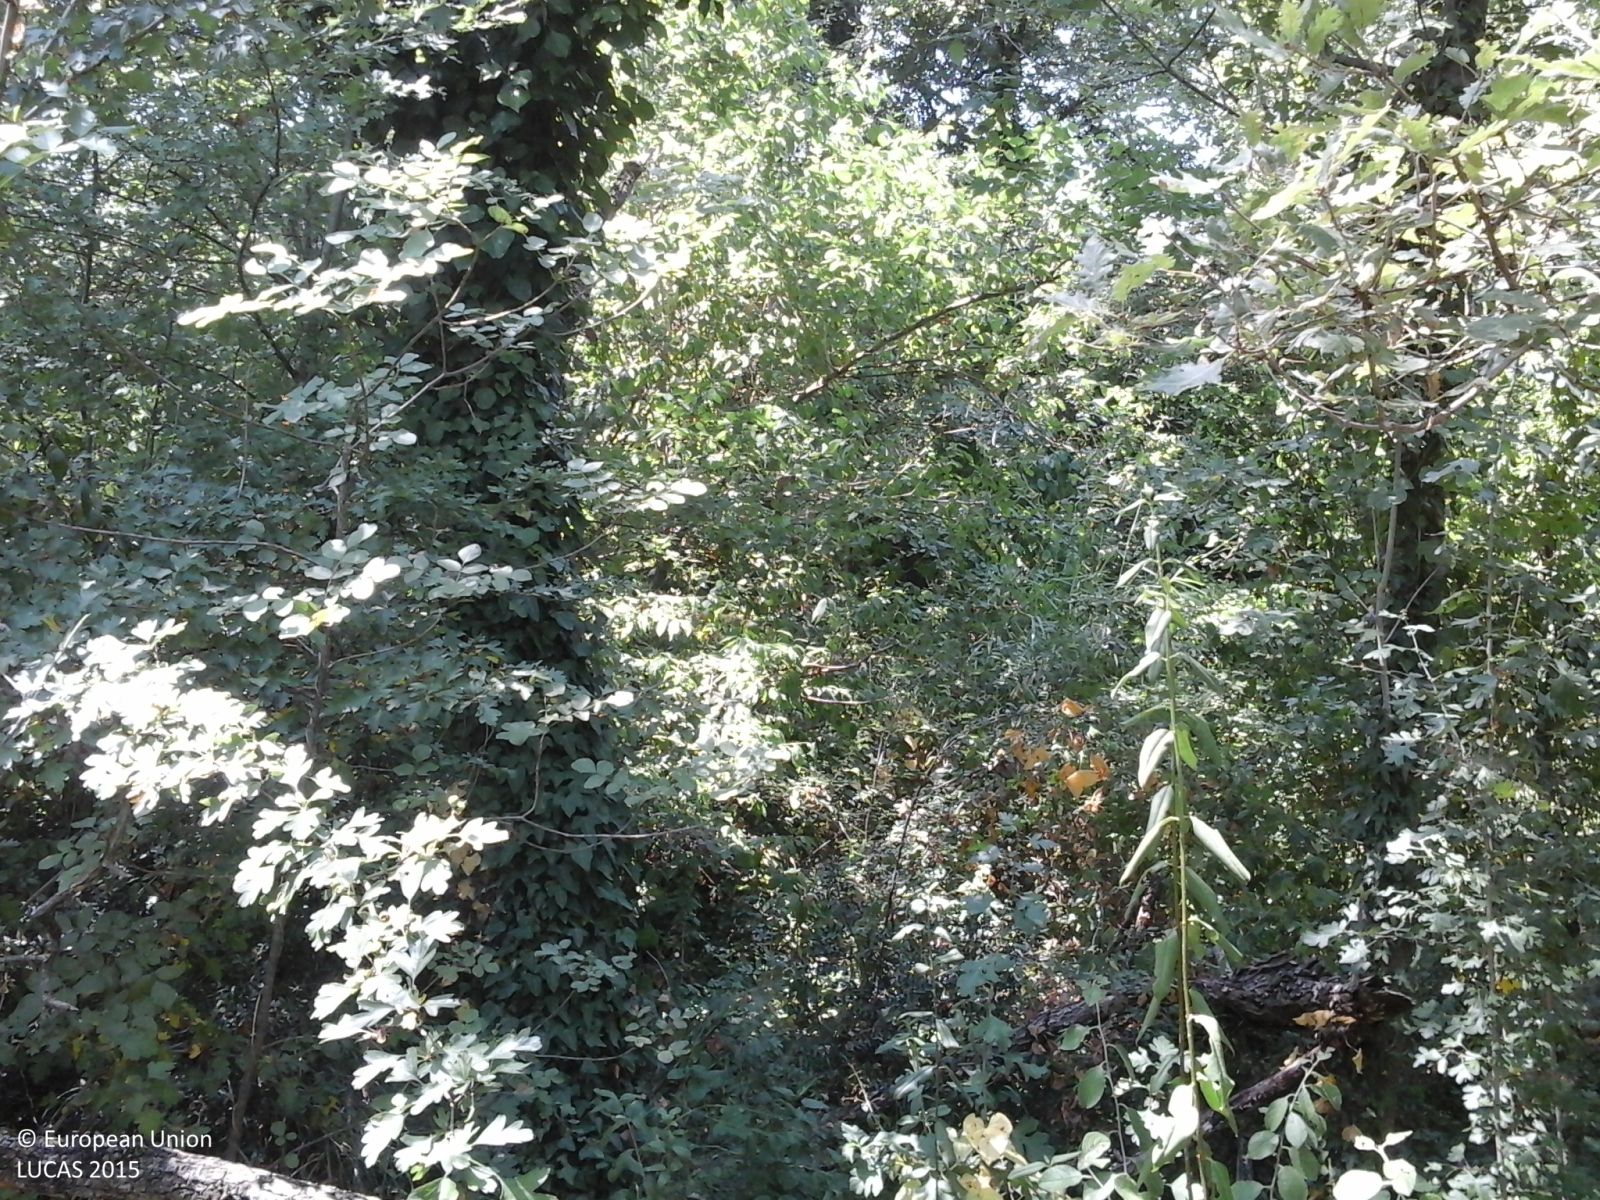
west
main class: Woodland
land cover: Broadleaved woodland
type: mesophytic deciduous forest
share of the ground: > 75 %
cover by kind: broadleaved forest trees 100 %
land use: Forestry
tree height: > 5 m
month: July
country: IT
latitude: 43.9450
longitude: 12.3492
